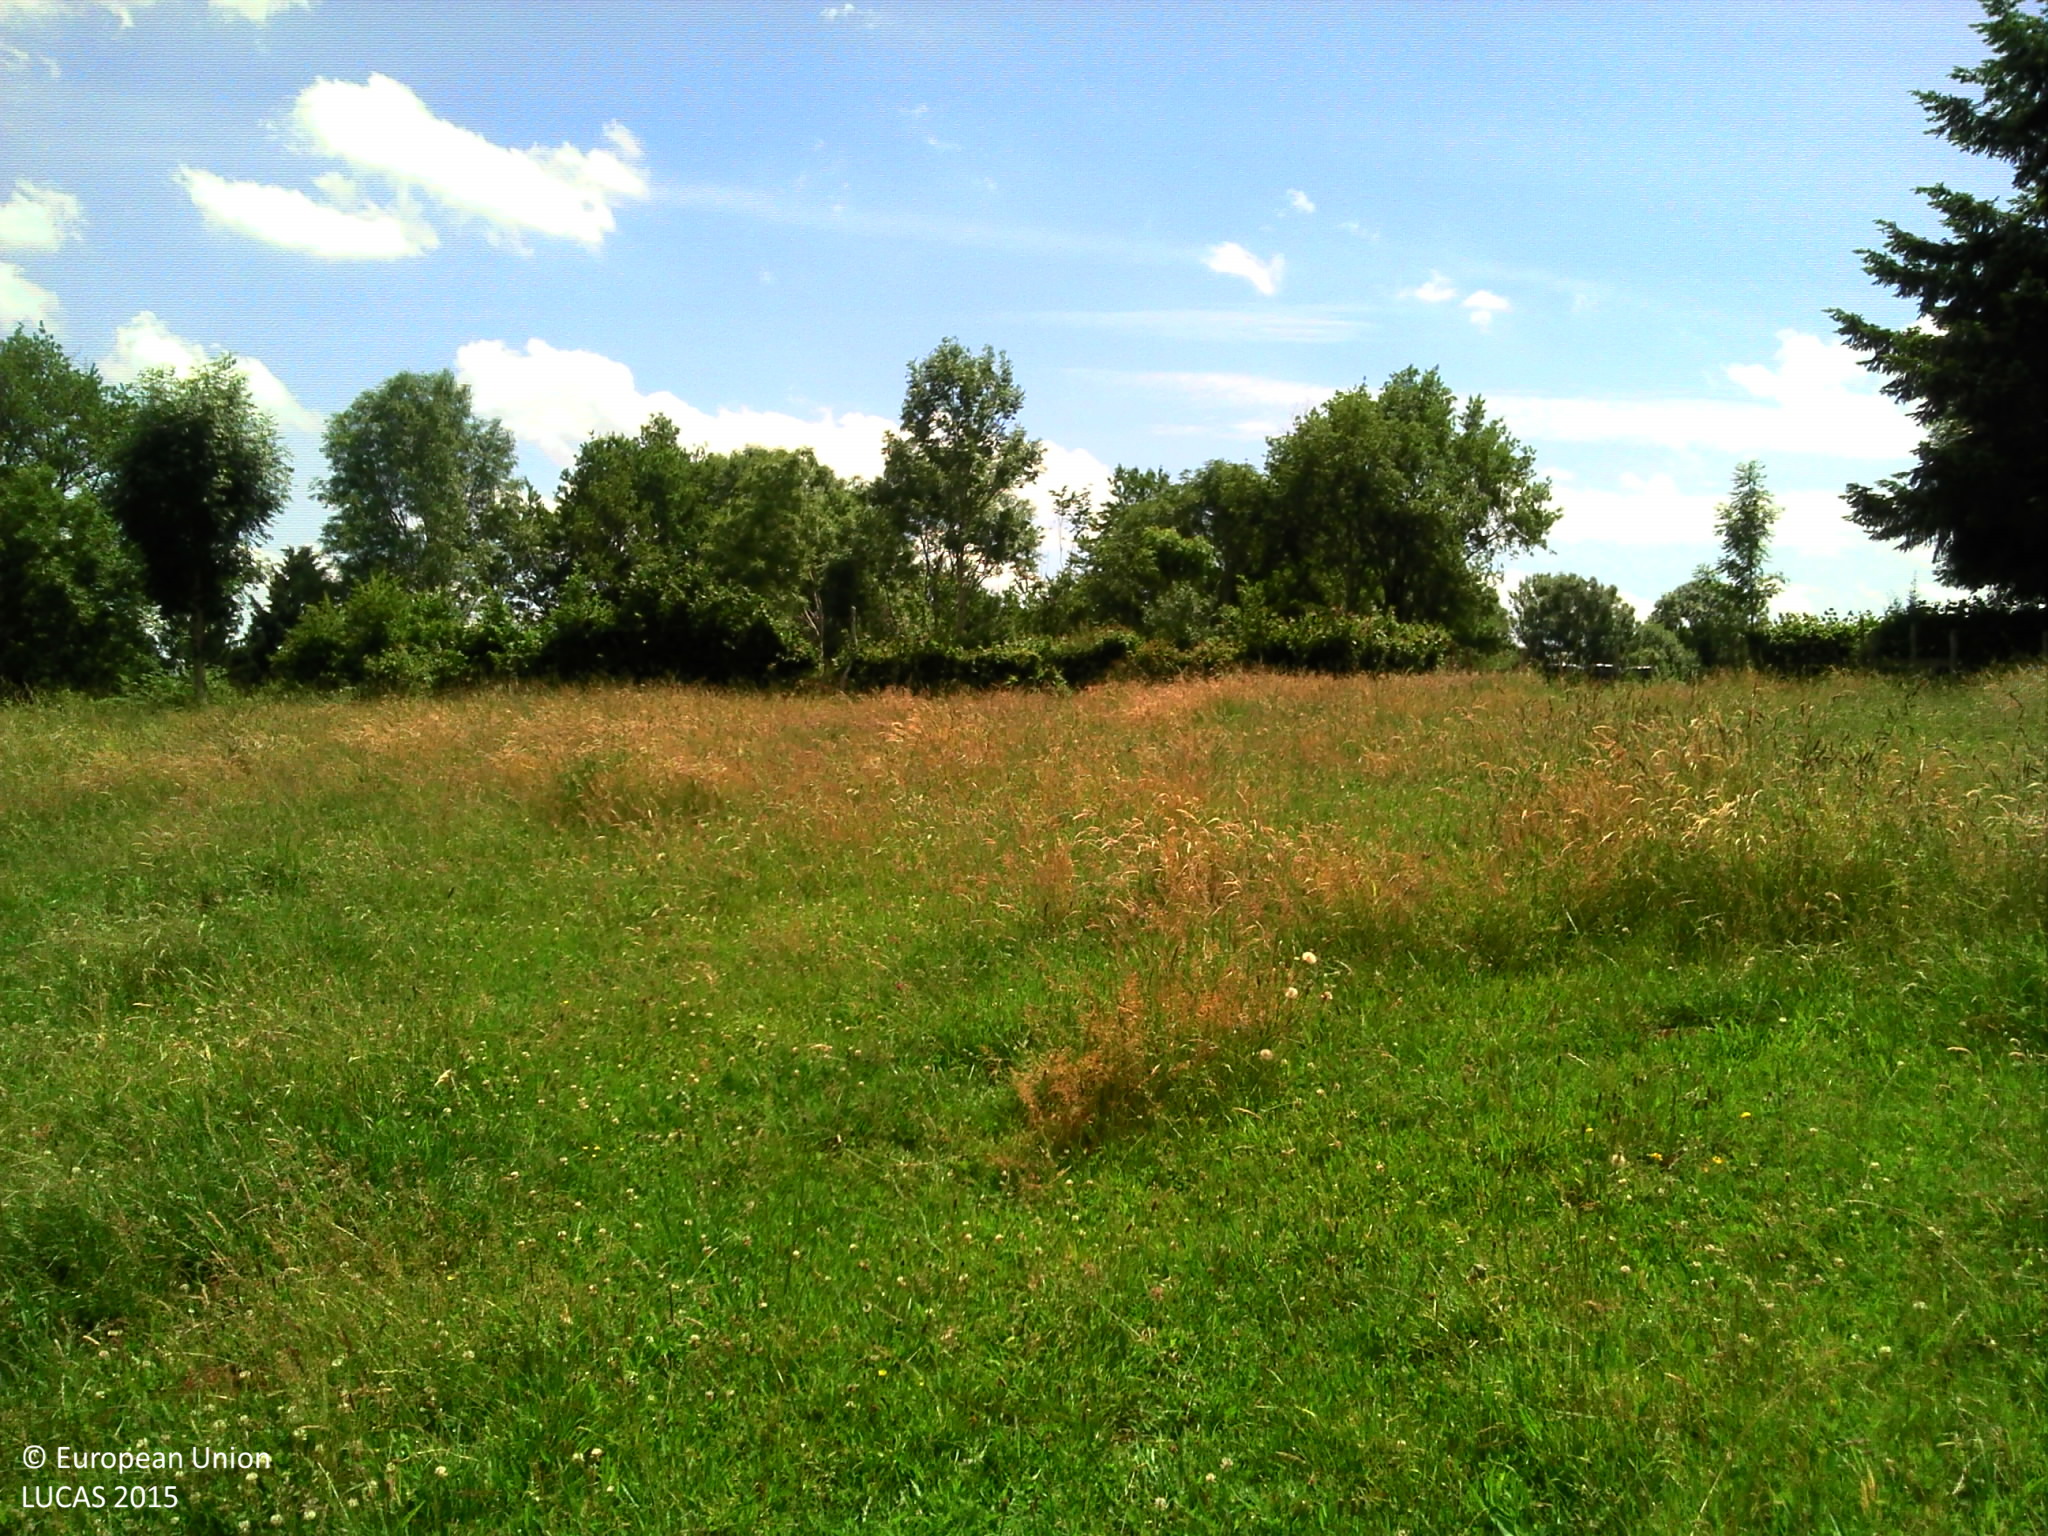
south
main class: Grassland
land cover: Grassland without tree/shrub cover
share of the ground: > 75 %
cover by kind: herbaceous plants 100 %
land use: Agriculture (excluding fallow land and kitchen gardens)
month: June
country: FR
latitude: 45.2262
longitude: 2.3445
